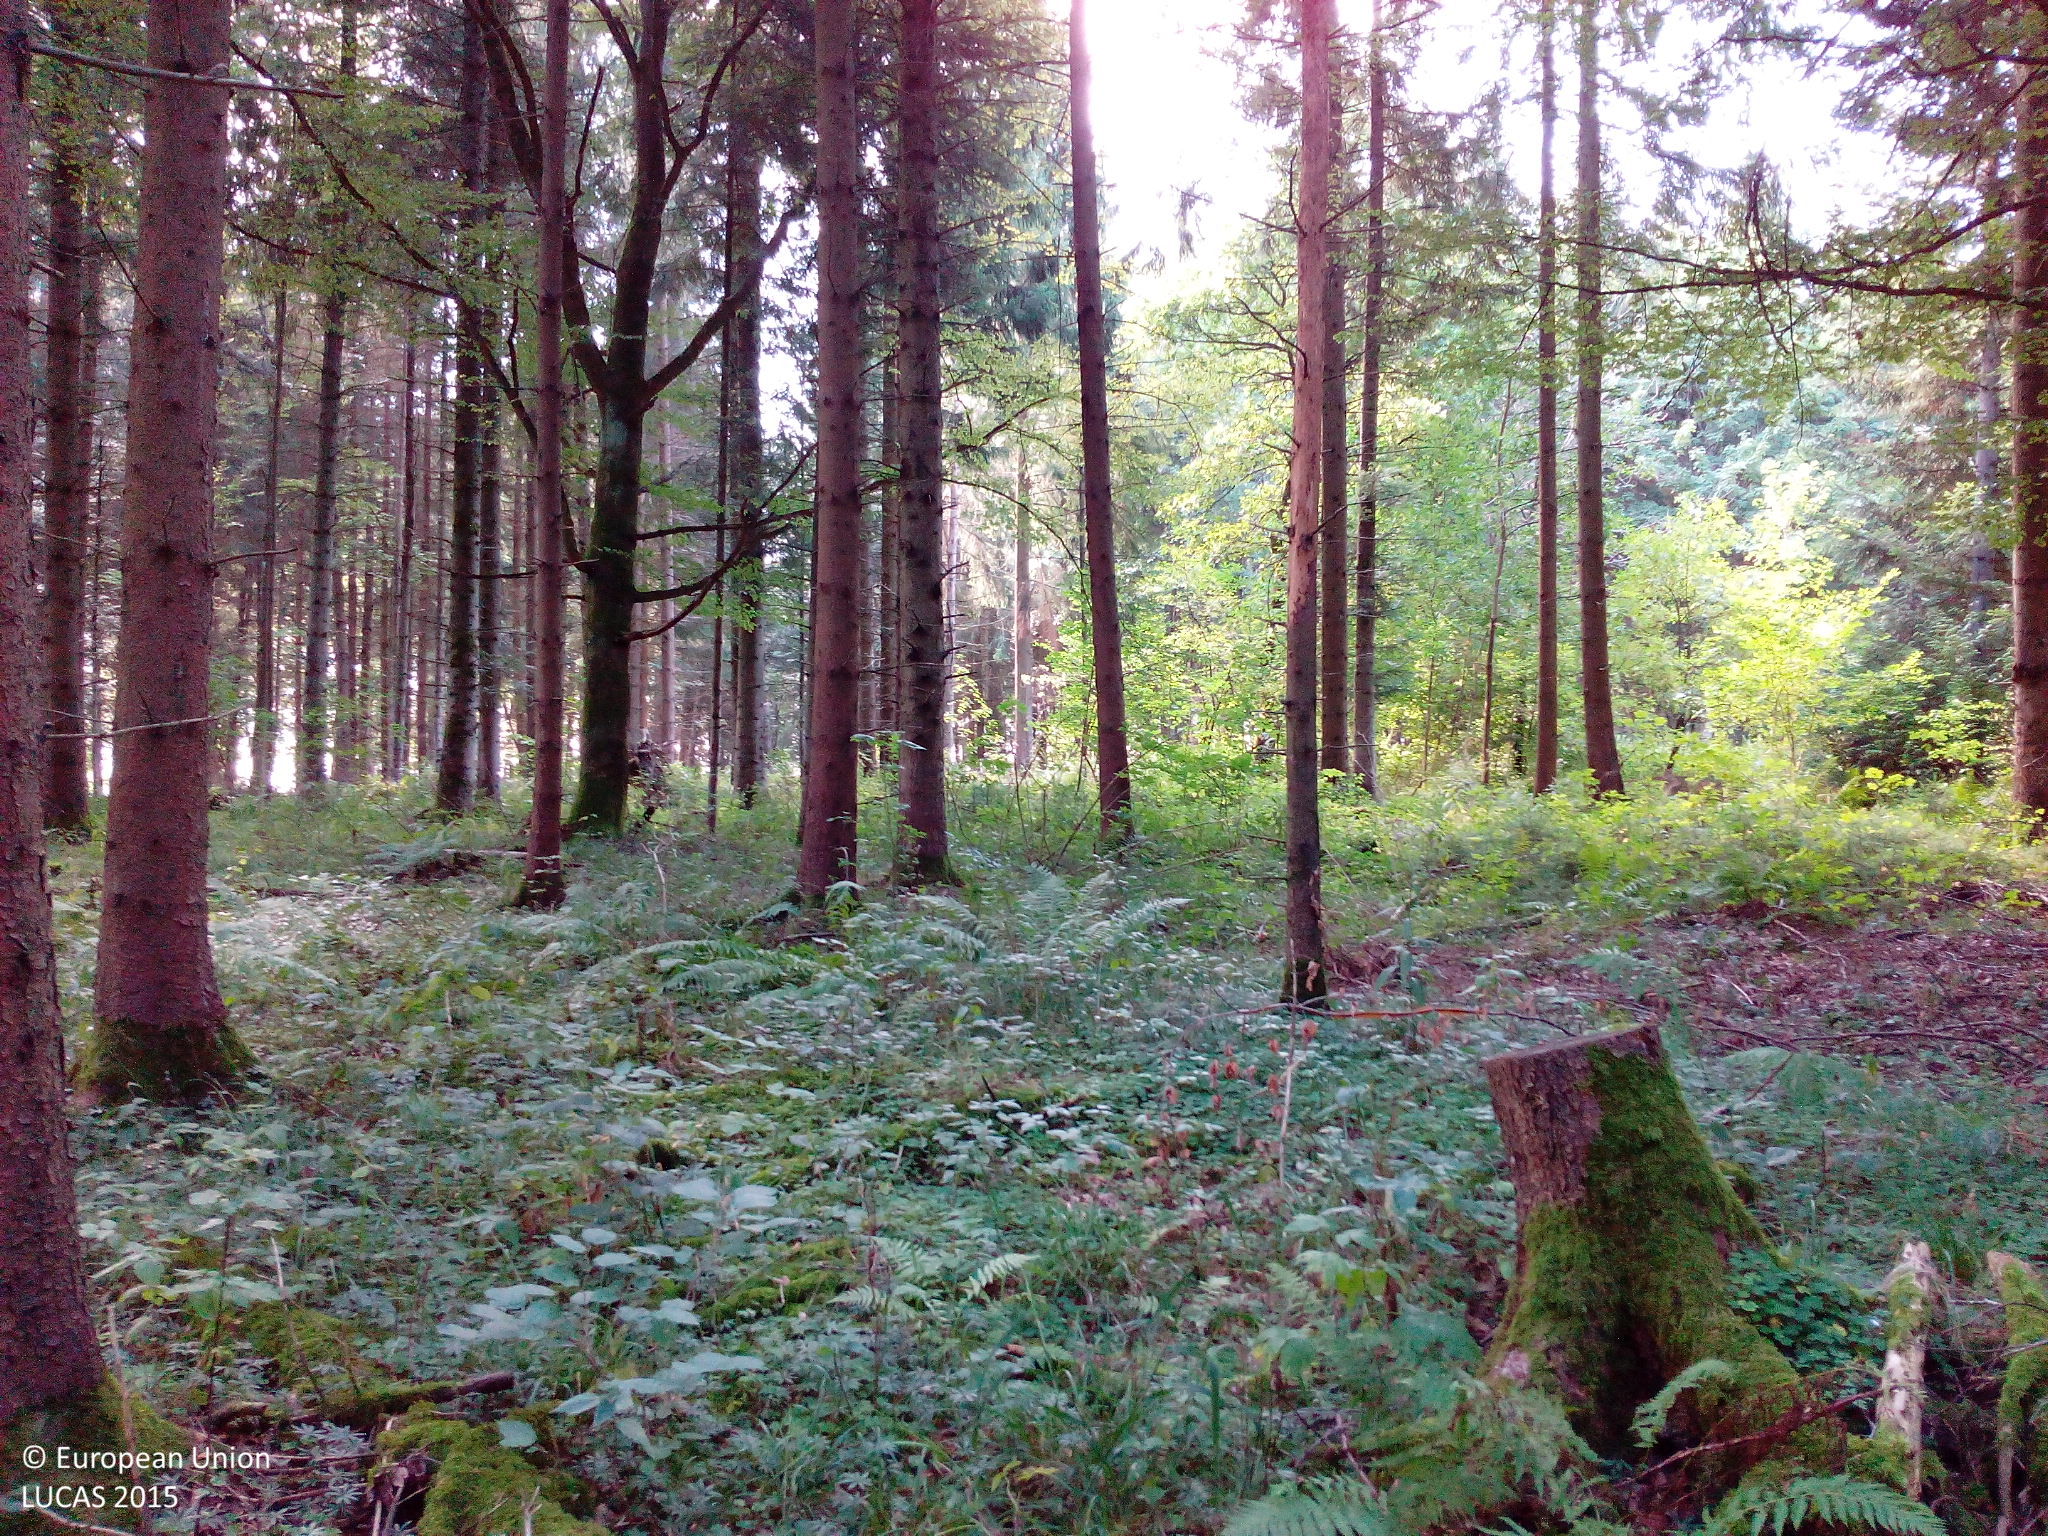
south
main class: Woodland
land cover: Spruce dominated coniferous woodland
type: hemiboreal forest and nemoral coniferous forest and mixed broadleaved-coniferous forest
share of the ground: 50 - 75 %
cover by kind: coniferous forest trees 55 %, herbaceous plants 20 %, lichens and mosses 10 %, broadleaved forest trees 5 %, shrubs 5 %, unconsolidated bare surface 5 %
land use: Forestry
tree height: > 5 m
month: September
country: DE
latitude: 48.1785
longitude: 8.5887
